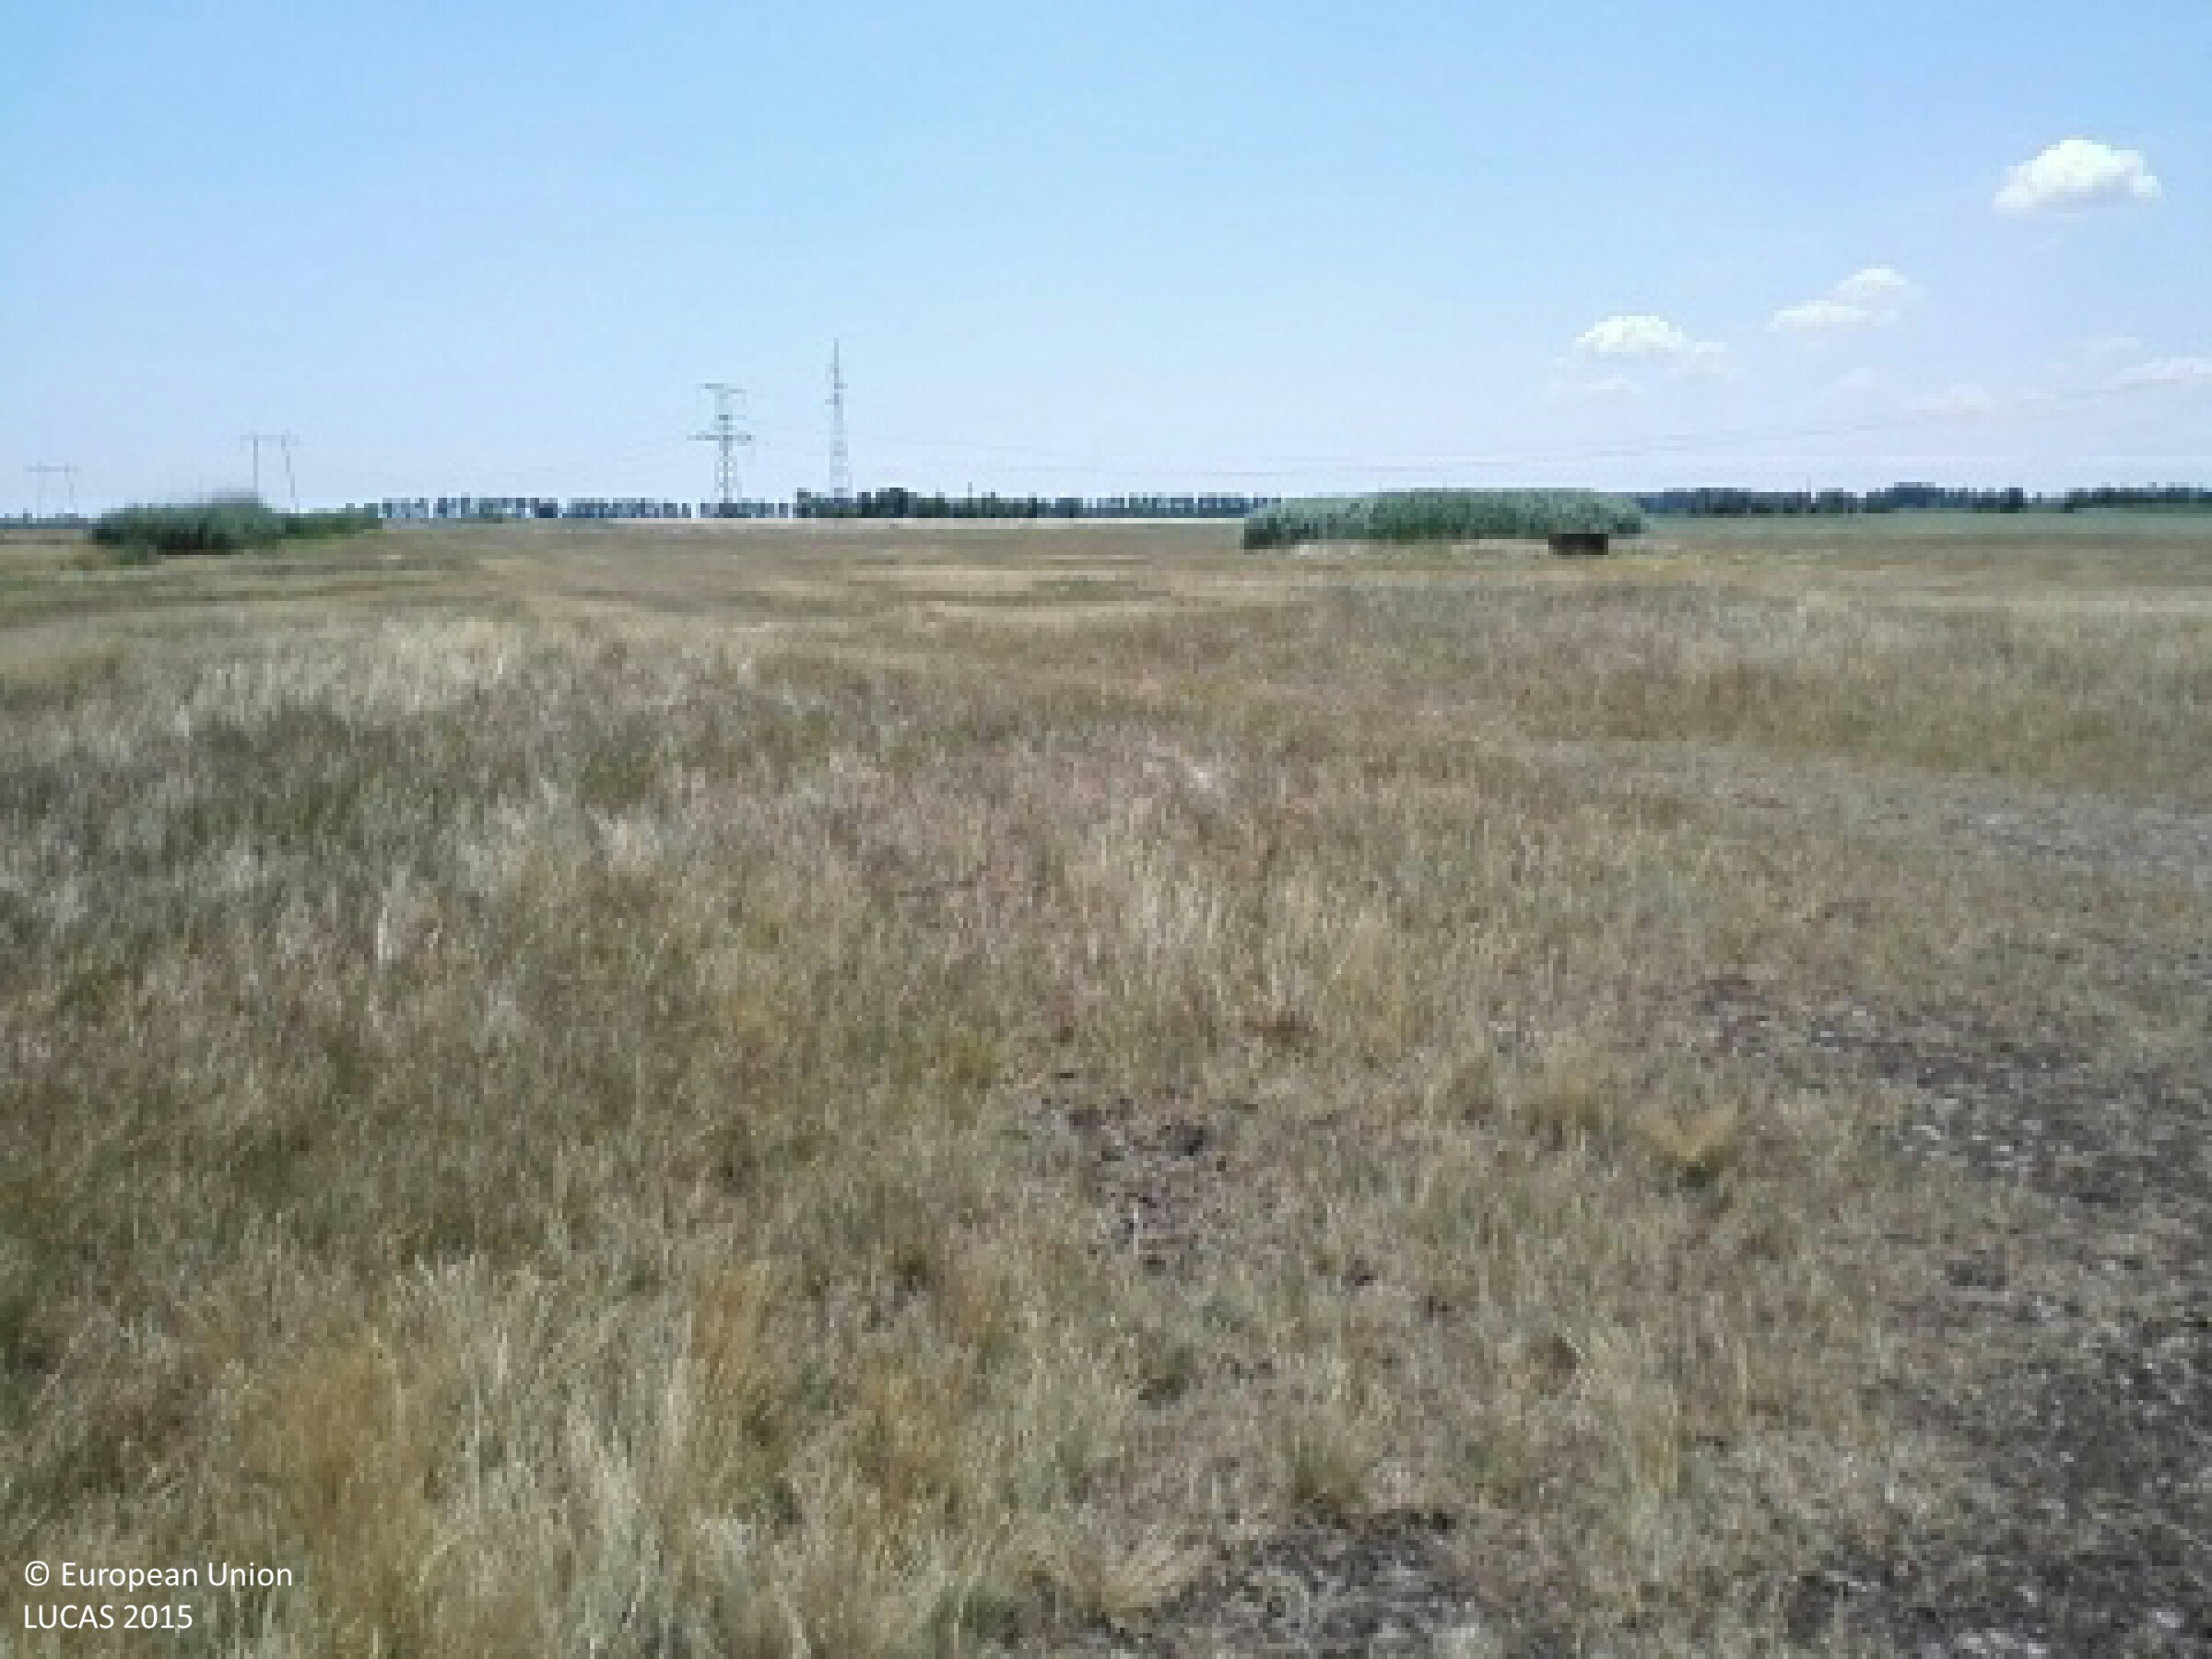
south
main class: Grassland
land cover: Grassland without tree/shrub cover
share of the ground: 25 - 50 %
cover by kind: herbaceous plants 95 %, consolidated bare surface 5 %
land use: Agriculture (excluding fallow land and kitchen gardens)
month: July
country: HU
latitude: 47.7045
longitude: 21.3835
